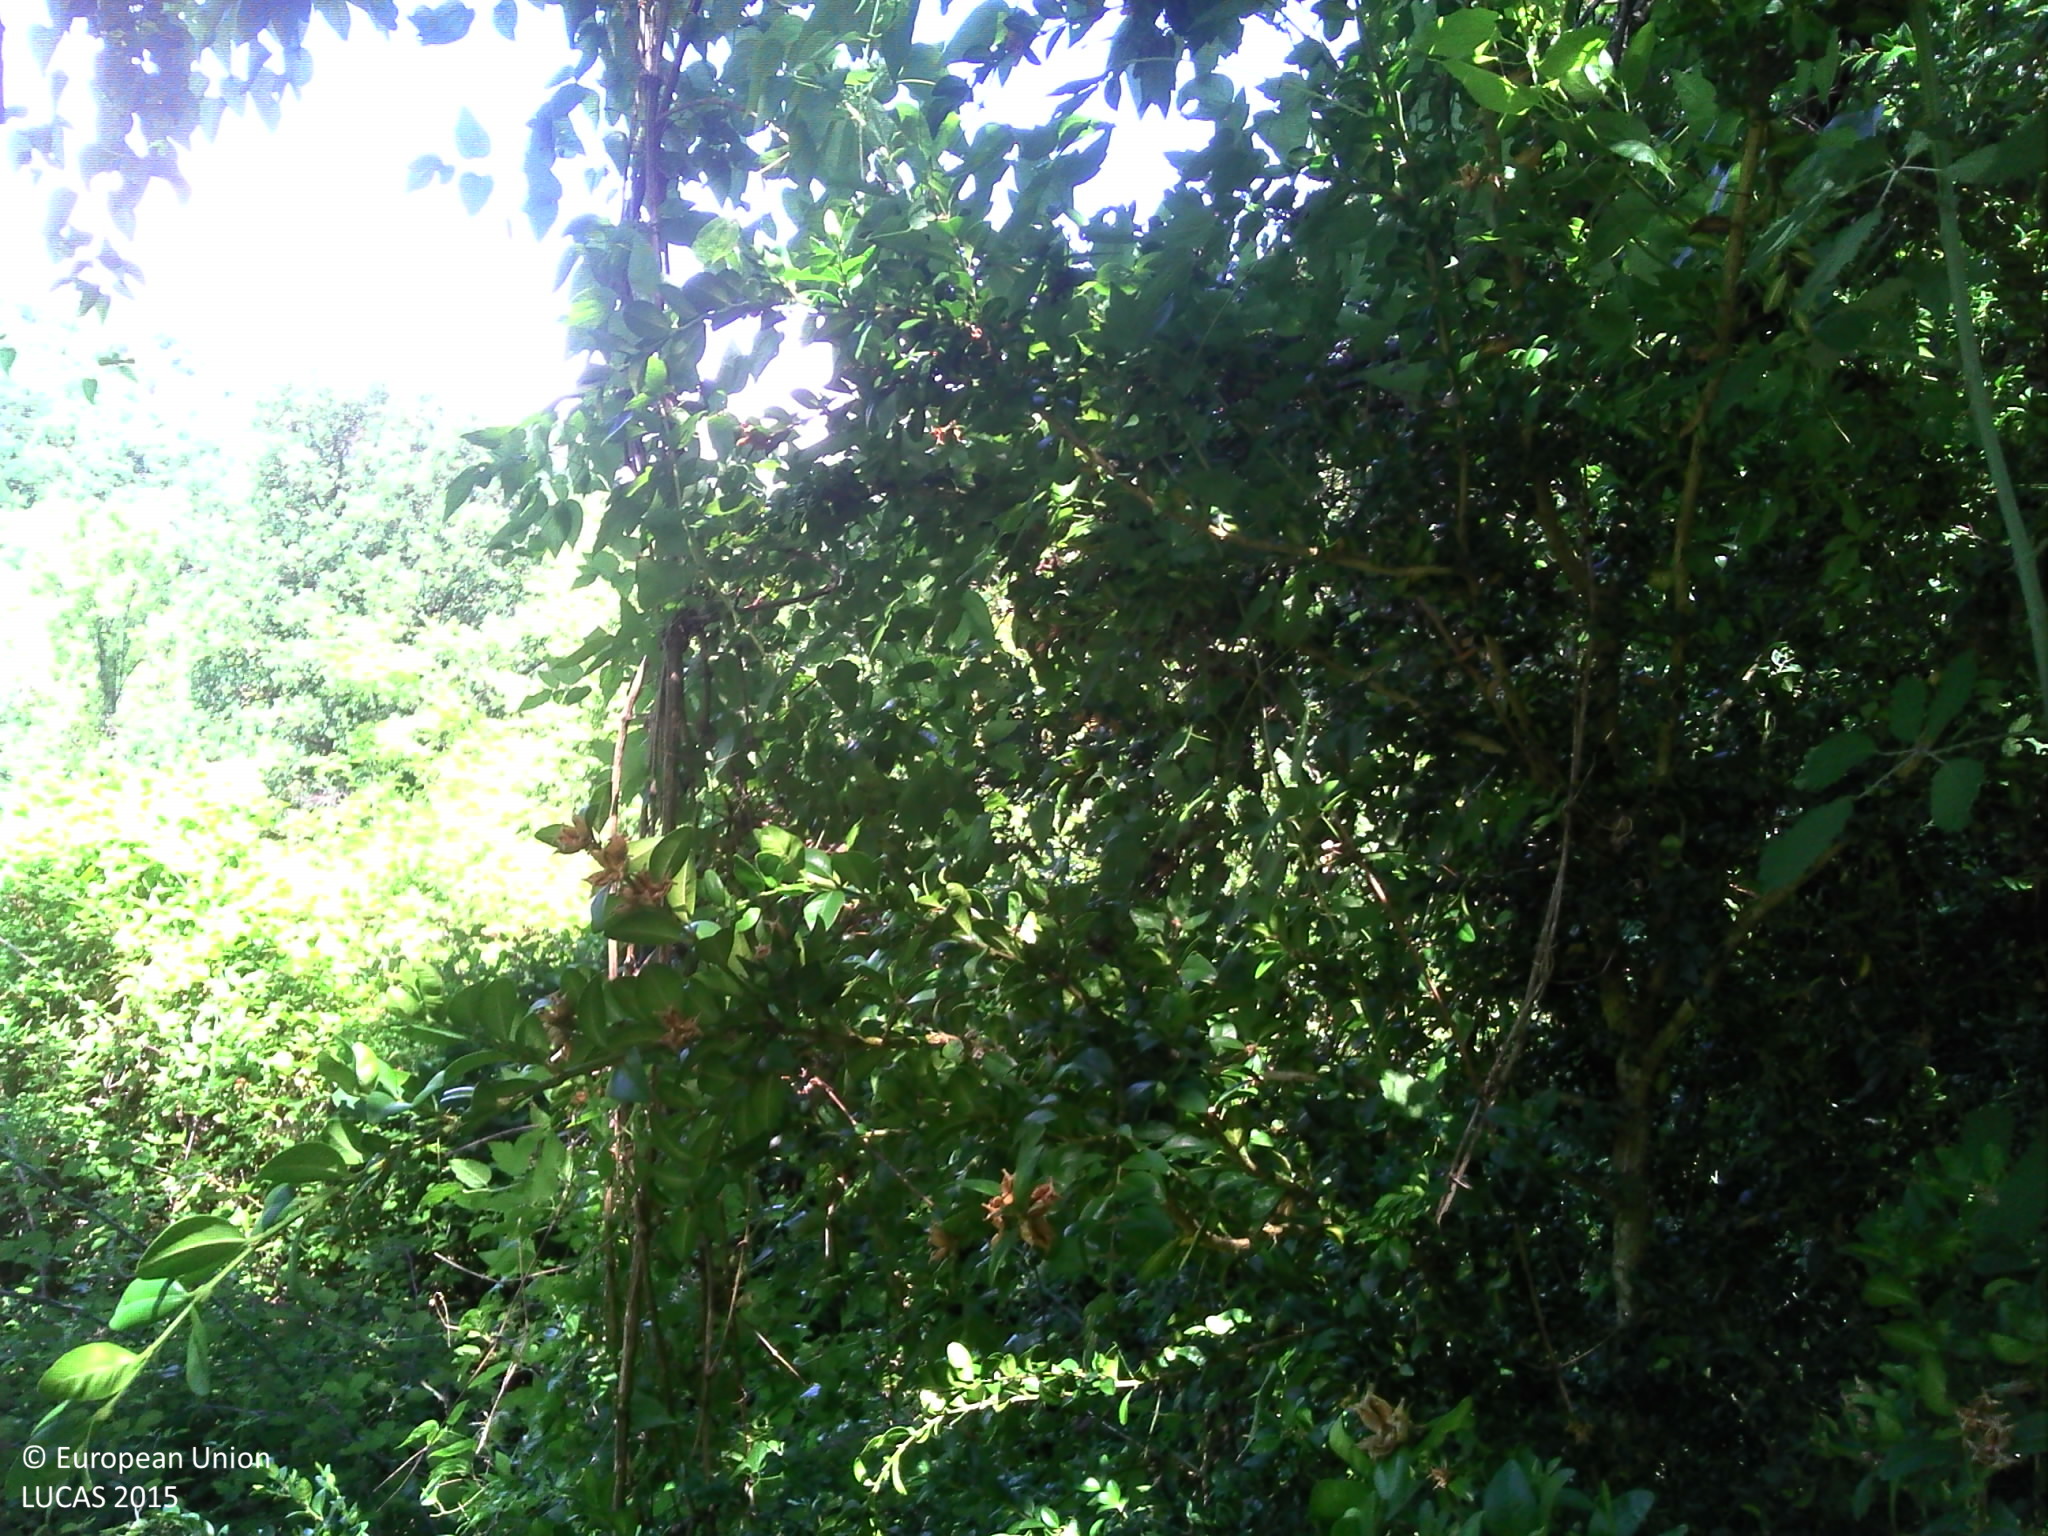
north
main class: Woodland
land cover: Broadleaved woodland
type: broadleaved evergreen forest
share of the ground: > 75 %
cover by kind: broadleaved forest trees 90 %, herbaceous plants 10 %
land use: Semi-natural and natural areas not in use
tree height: > 5 m
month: July
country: FR
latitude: 44.6988
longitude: 4.6175
